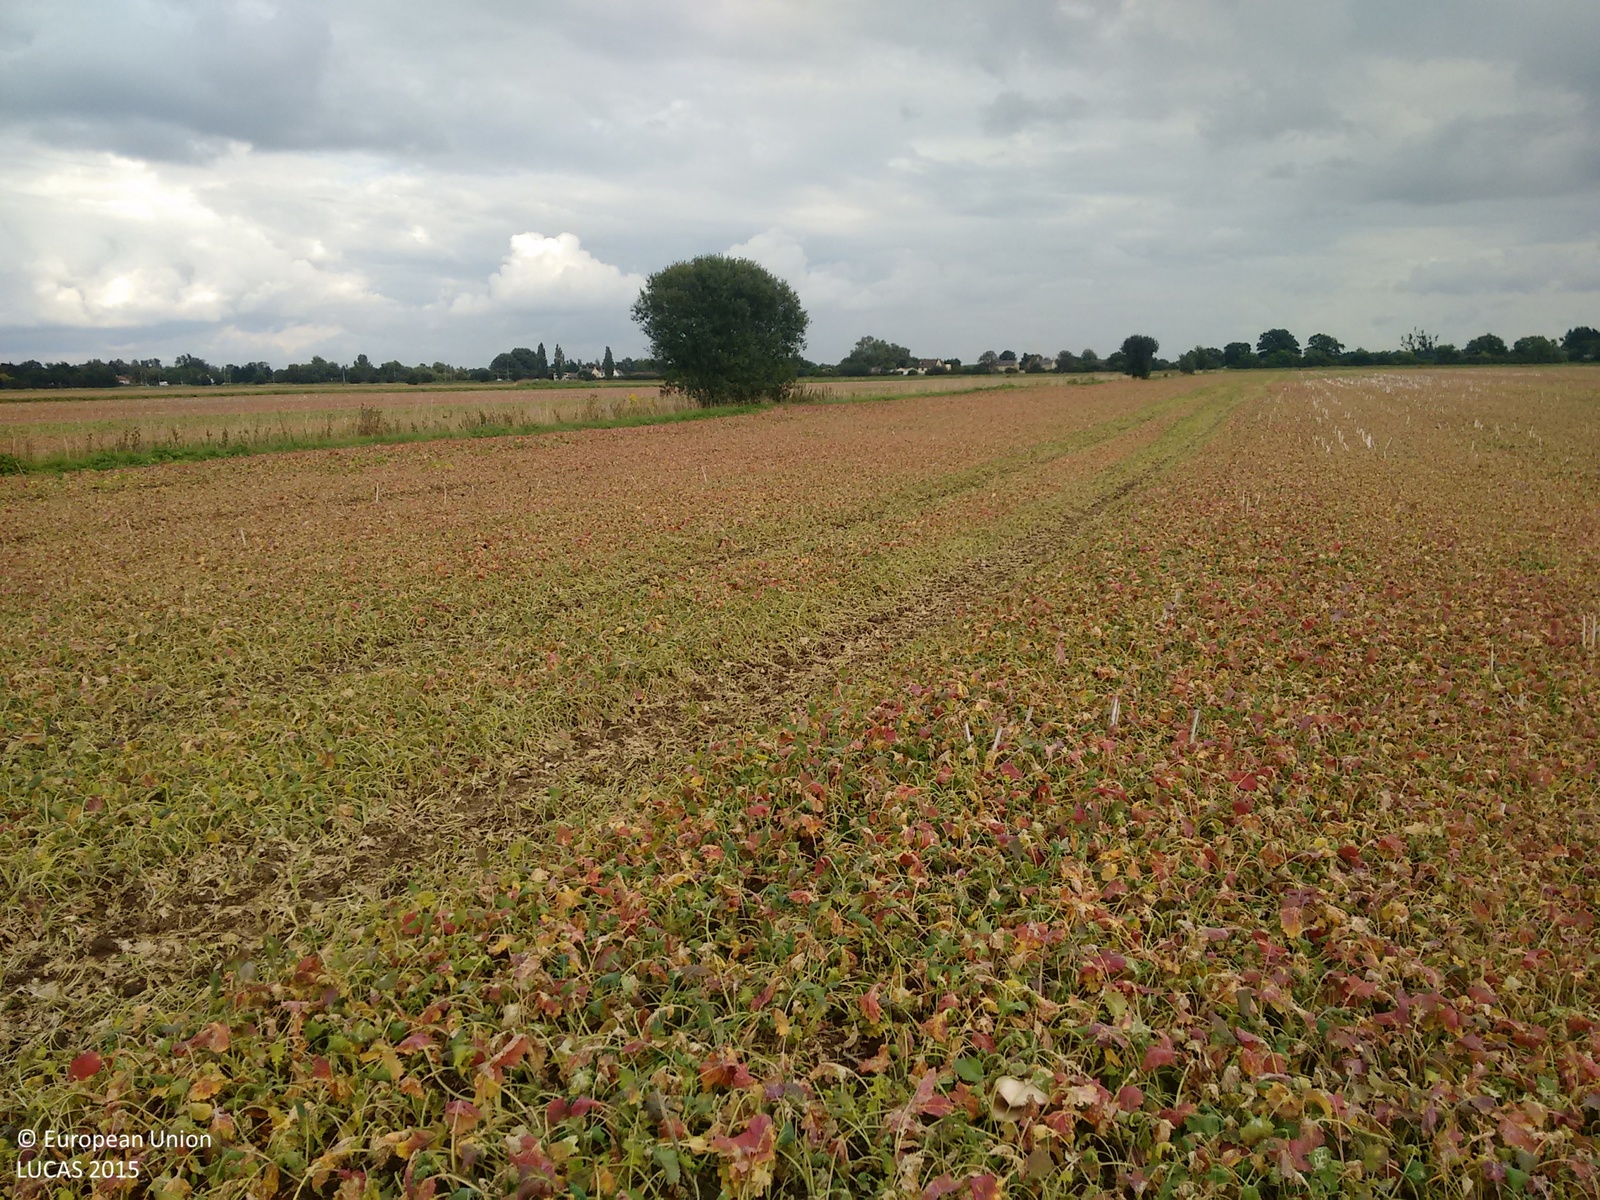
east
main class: Cropland
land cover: Rape and turnip rape
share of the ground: > 75 %
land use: Agriculture (excluding fallow land and kitchen gardens)
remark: Harvested field
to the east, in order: Rape and turnip rape; Grassland with sparse tree/shrub cover; Ditches and canals; Grassland without tree/shrub cover; Spontaneously vegetated surfaces
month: September
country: GB
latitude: 52.2582
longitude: 0.1680
